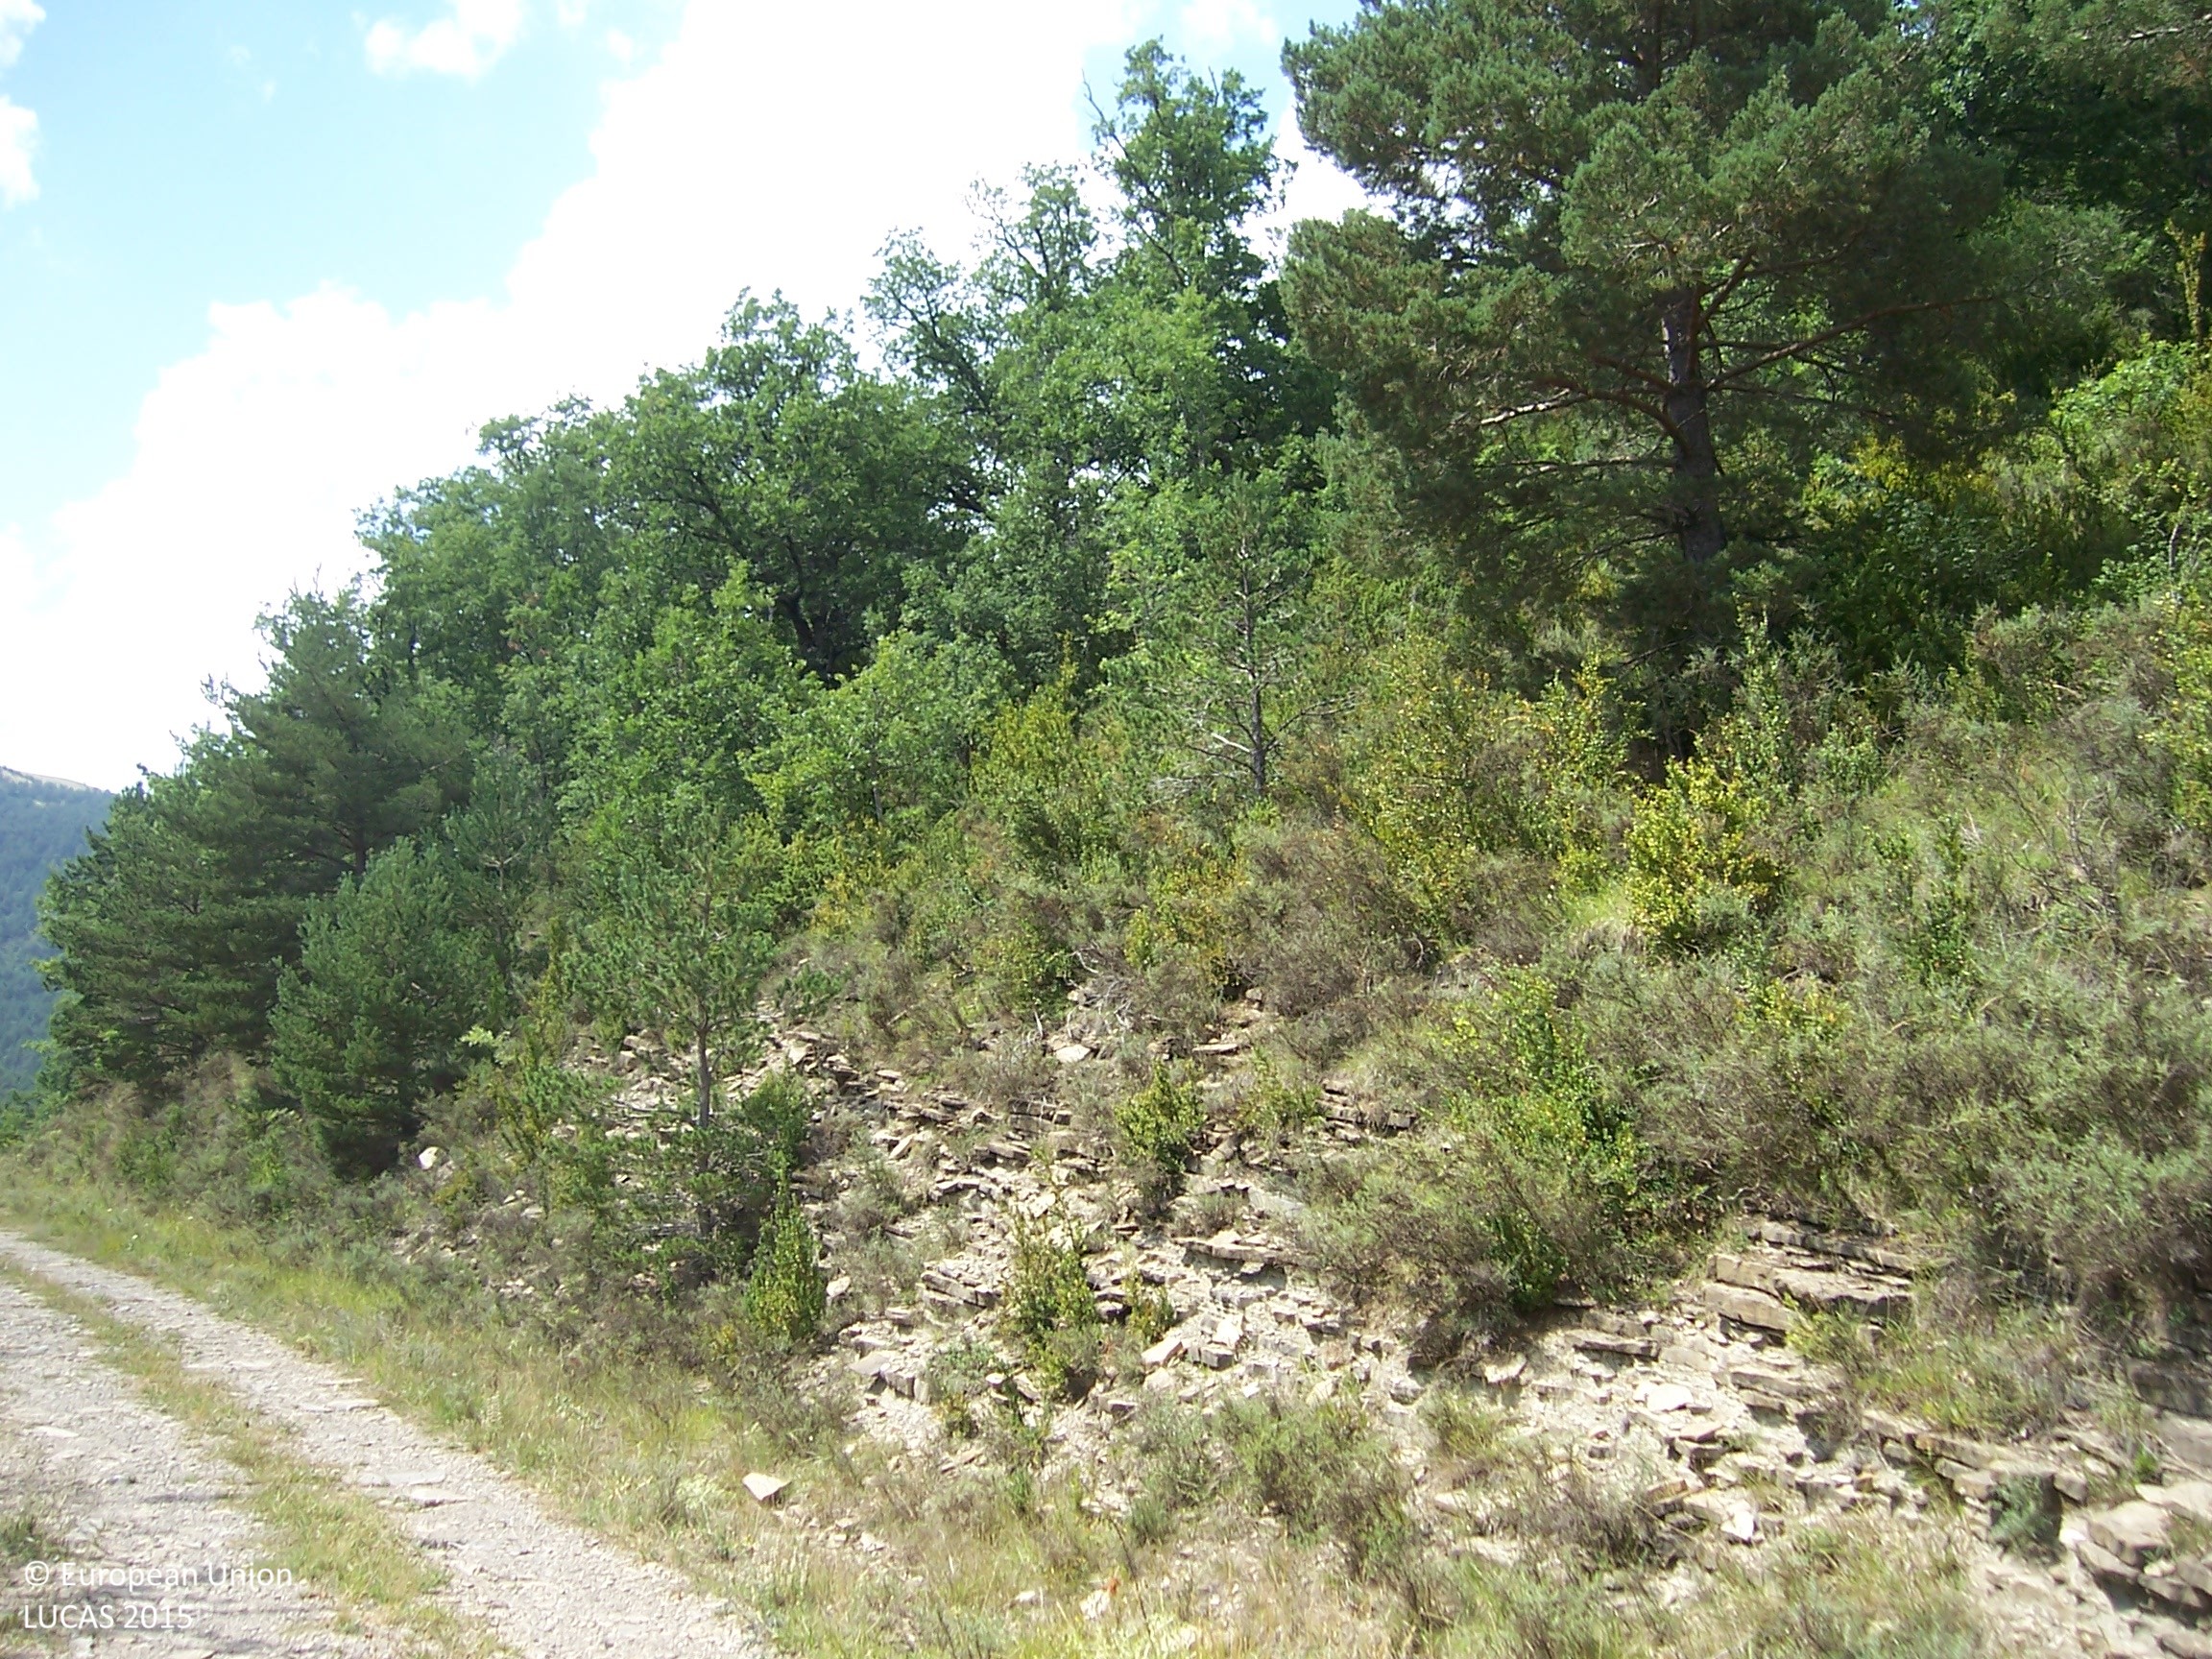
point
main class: Woodland
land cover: Pine dominated coniferous woodland
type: alpine coniferous forest
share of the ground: > 75 %
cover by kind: coniferous forest trees 85 %, shrubs 10 %, unconsolidated bare surface 5 %
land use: Forestry
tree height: > 5 m
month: August
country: ES
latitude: 42.6467
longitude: -0.3818
